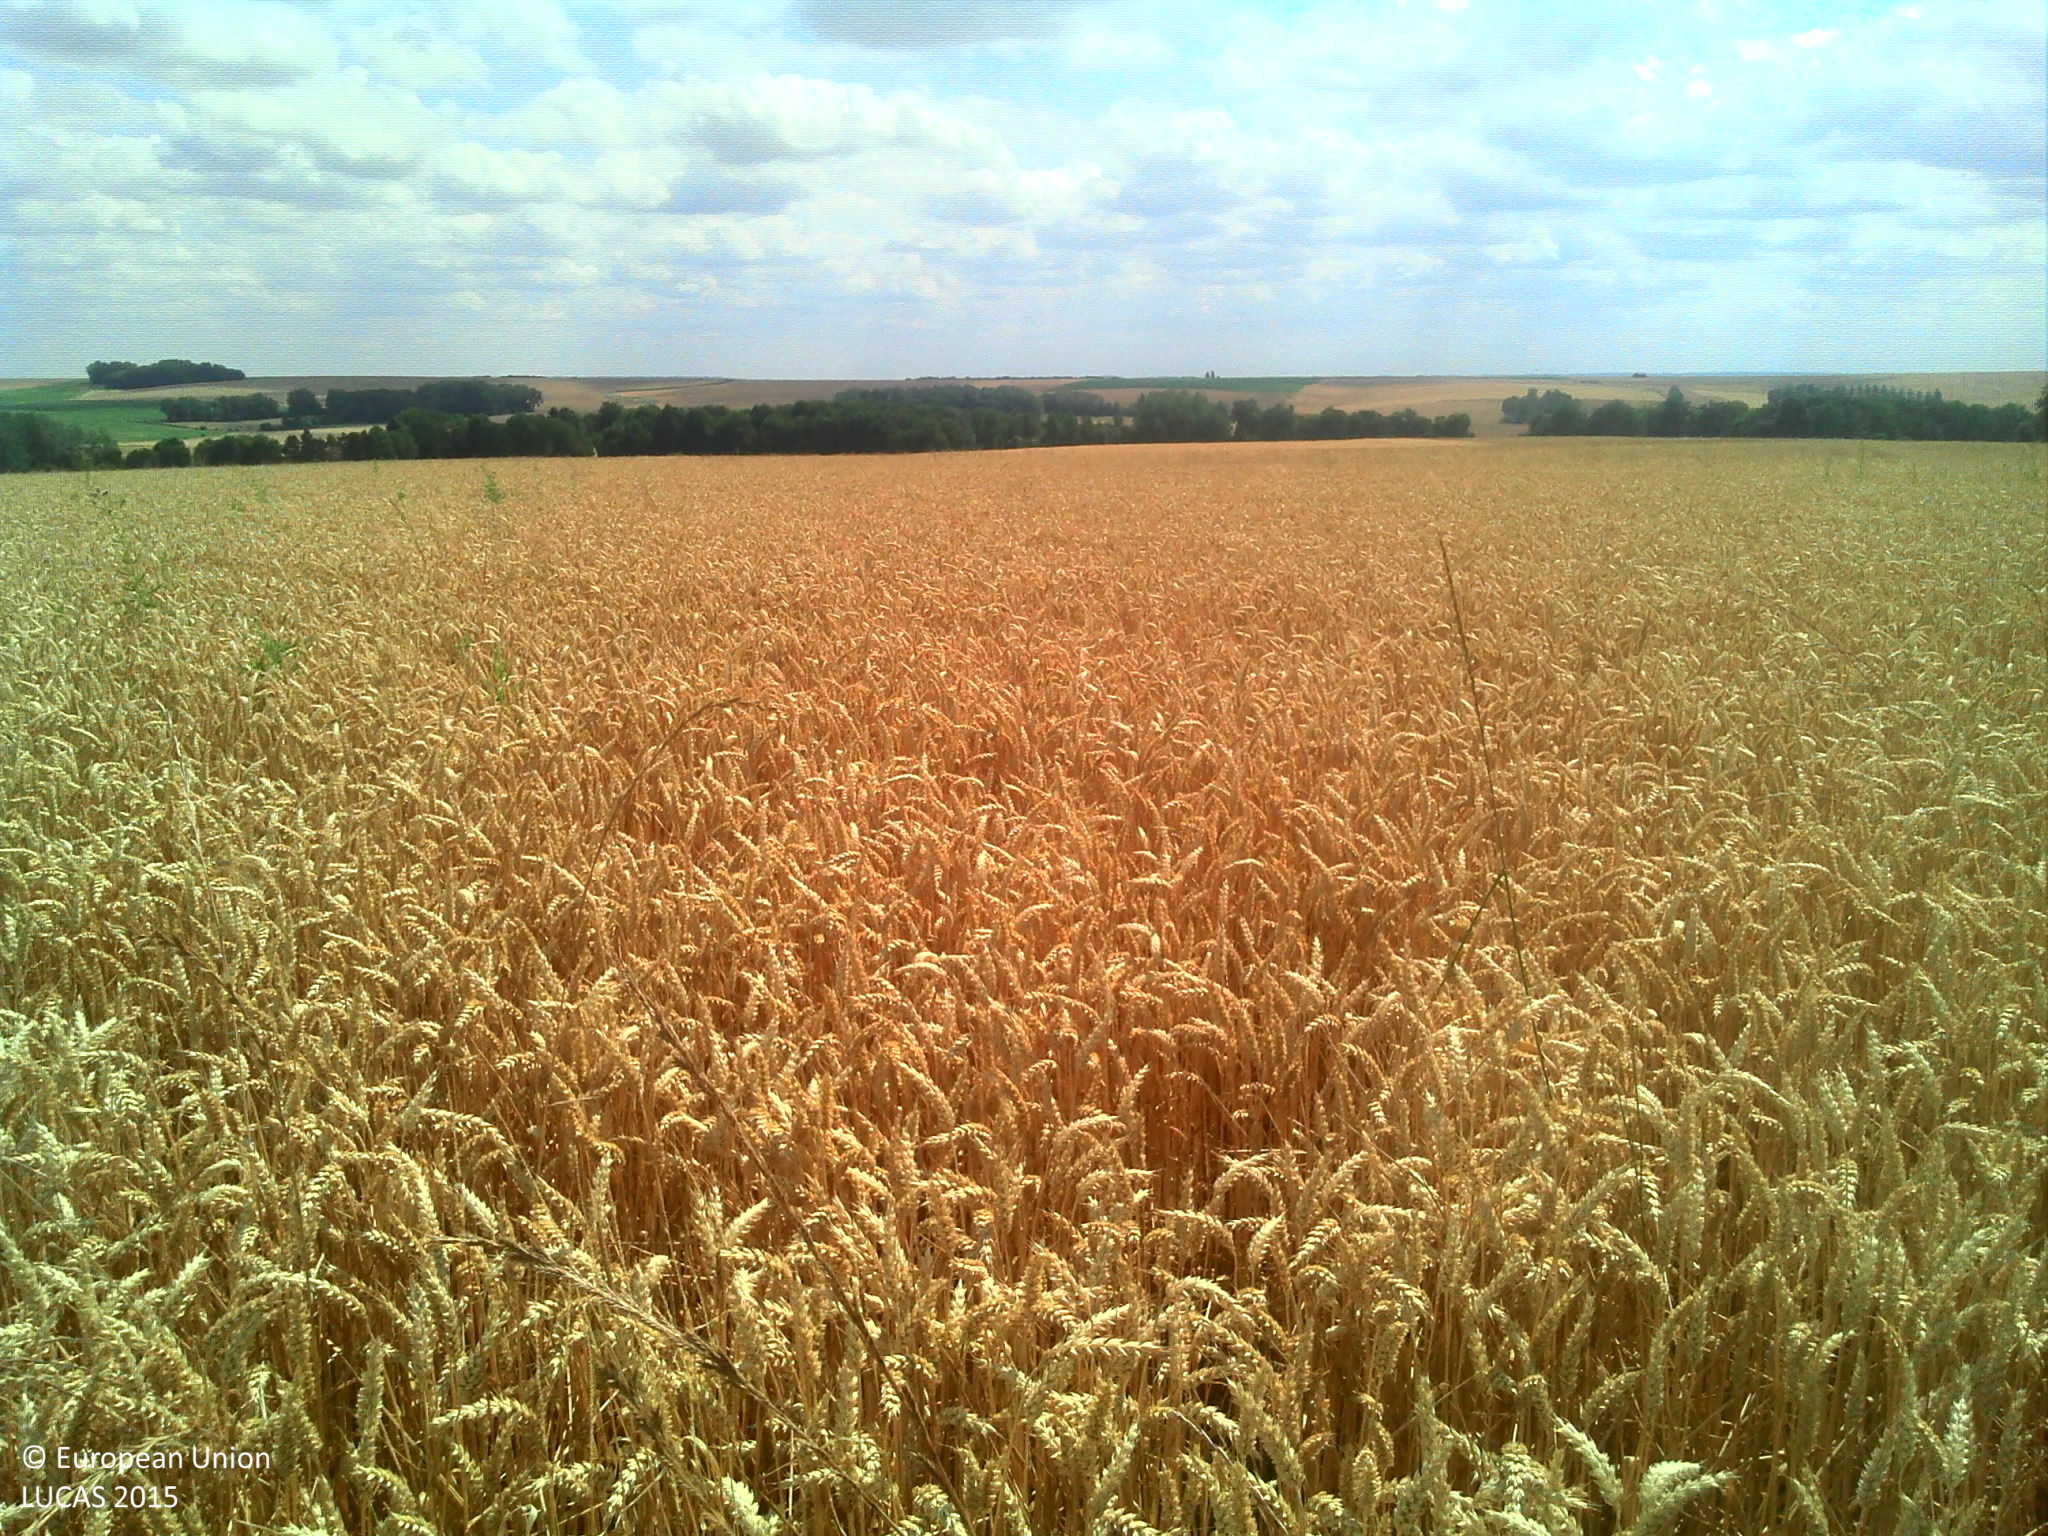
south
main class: Cropland
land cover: Common wheat
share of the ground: > 75 %
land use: Agriculture (excluding fallow land and kitchen gardens)
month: July
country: FR
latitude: 49.2473
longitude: 3.3022
